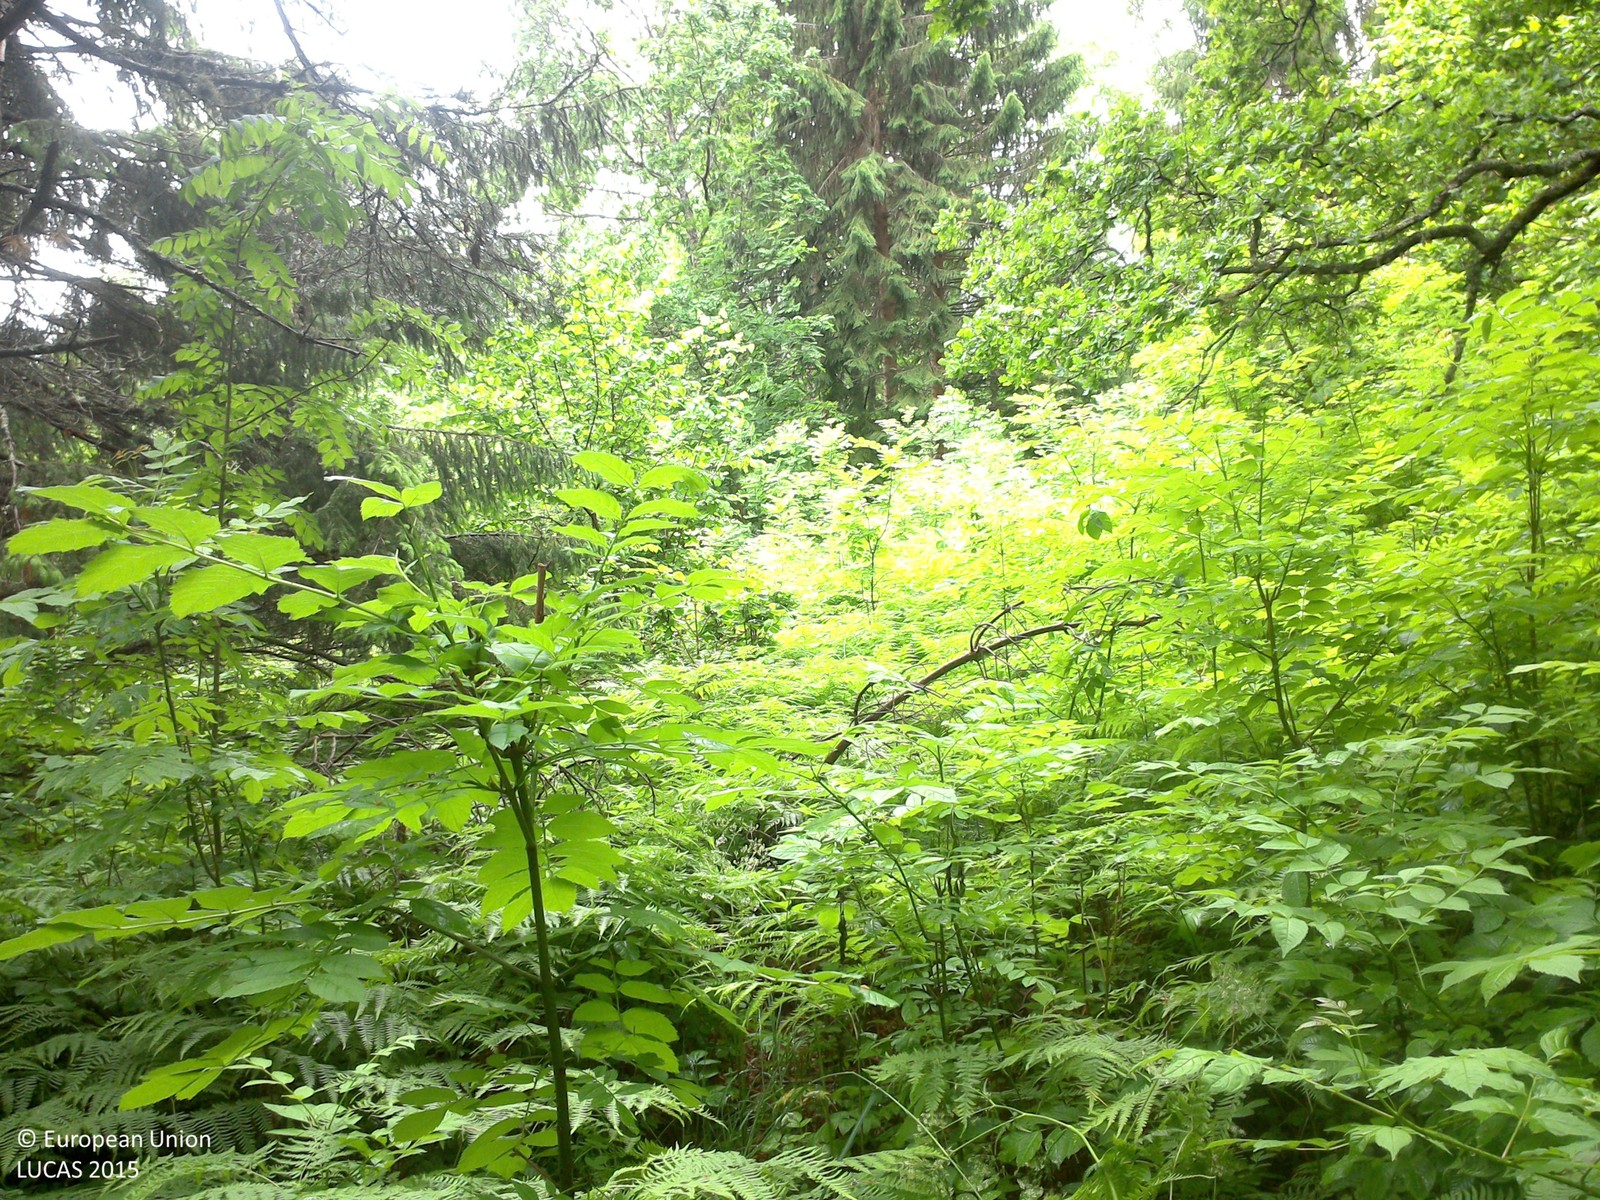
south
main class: Woodland
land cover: Broadleaved woodland
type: boreal forest
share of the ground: > 75 %
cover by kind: broadleaved forest trees 75 %, herbaceous plants 25 %
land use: Forestry
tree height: > 5 m
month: June
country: SE
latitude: 58.0665
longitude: 15.6062
